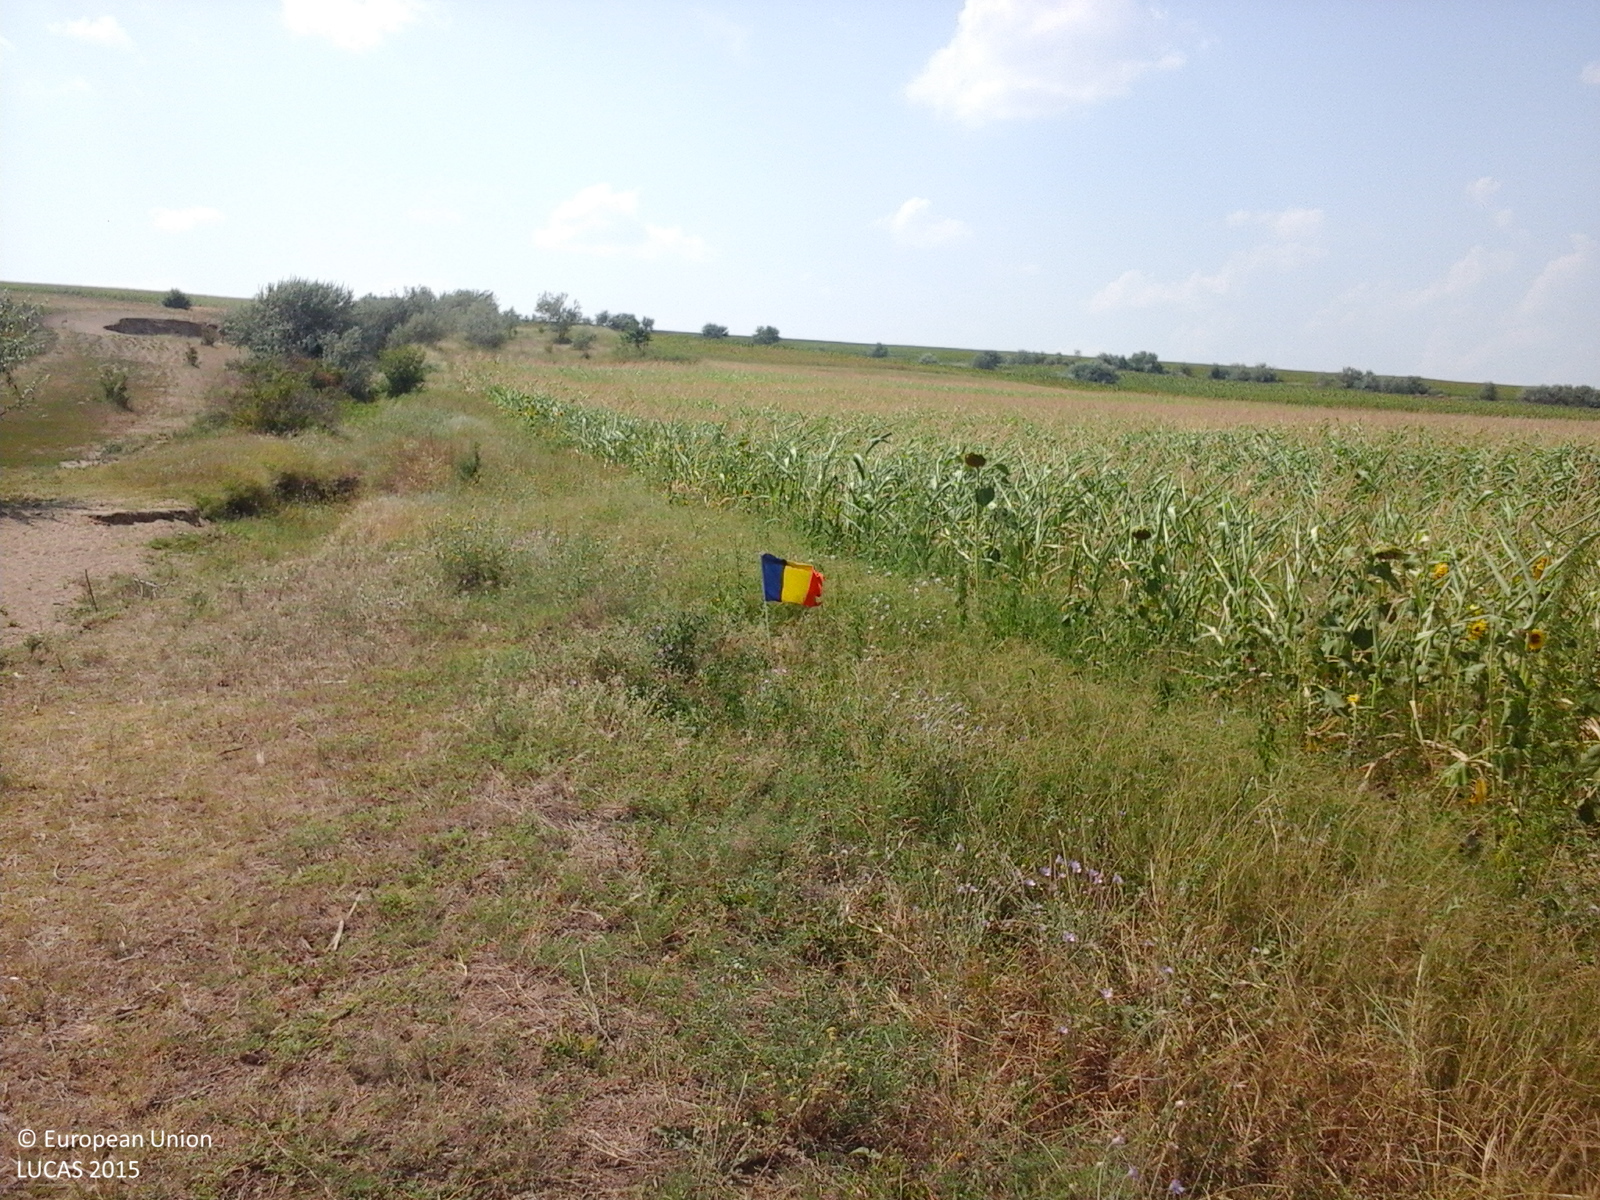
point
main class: Grassland
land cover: Spontaneously vegetated surfaces
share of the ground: > 75 %
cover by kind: herbaceous plants 100 %
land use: Semi-natural and natural areas not in use
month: July
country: RO
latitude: 45.9178
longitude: 27.9781
